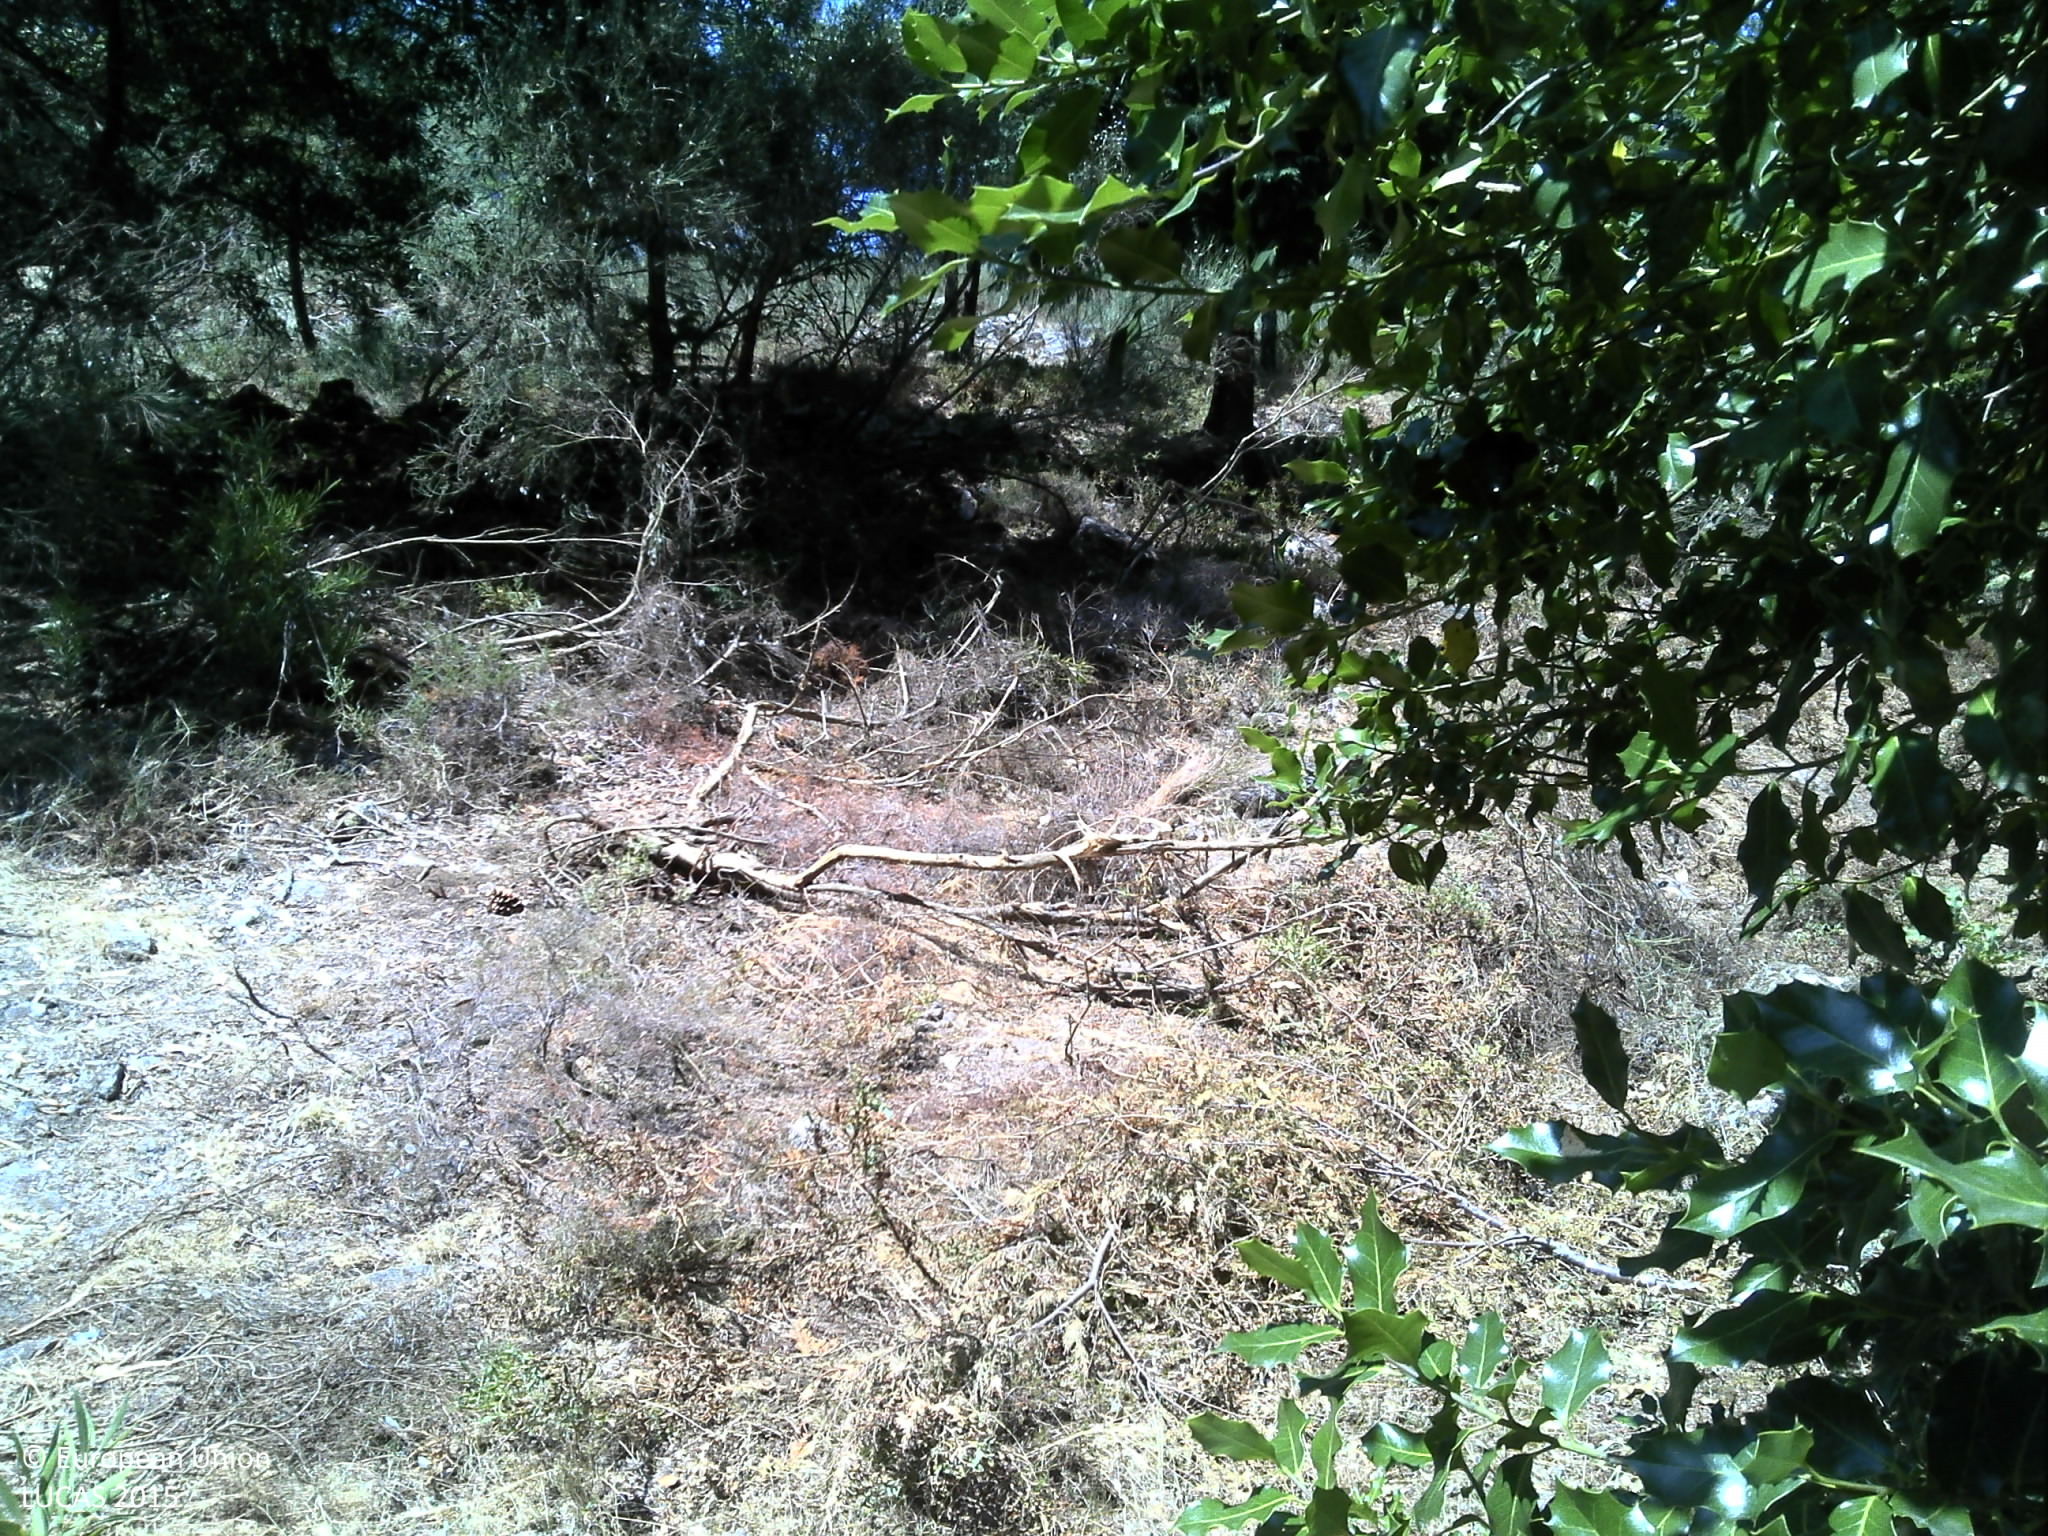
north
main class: Woodland
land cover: Other coniferous woodland
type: coniferous forest of the mediterranean region
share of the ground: 50 - 75 %
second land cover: Grassland without tree/shrub cover
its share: 25 - 50 %
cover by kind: coniferous forest trees 70 %, herbaceous plants 20 %, shrubs 5 %, unconsolidated bare surface 5 %
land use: Forestry
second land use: Agriculture (excluding fallow land and kitchen gardens)
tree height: > 5 m
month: July
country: PT
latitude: 41.6581
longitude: -8.0744
